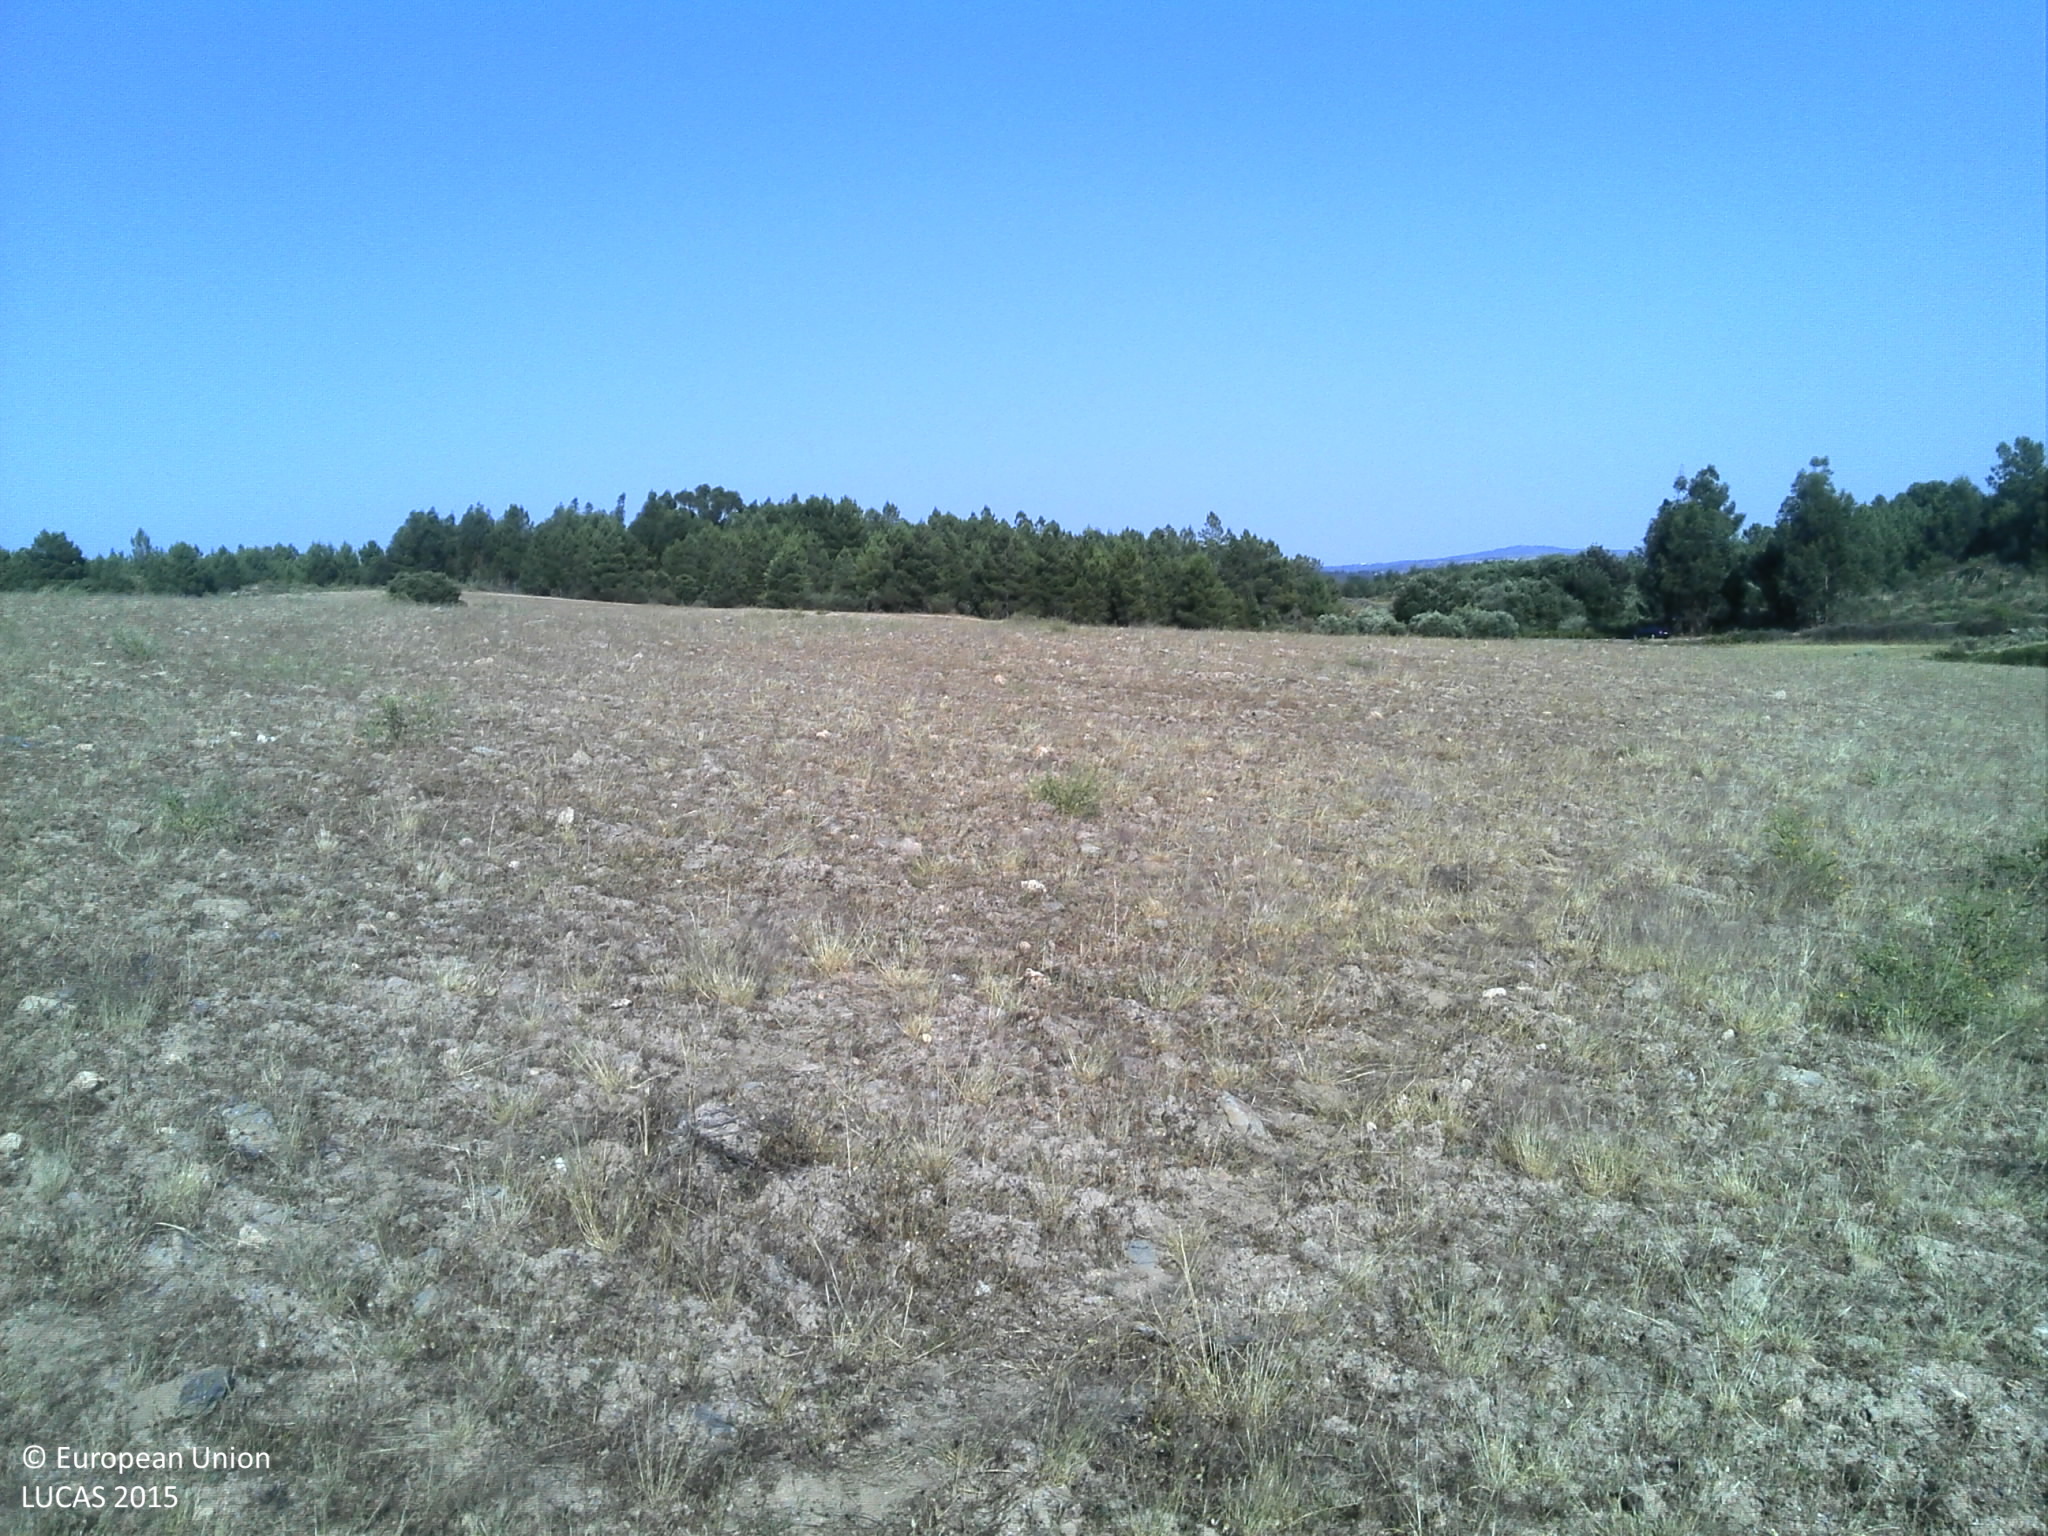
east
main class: Grassland
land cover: Spontaneously vegetated surfaces
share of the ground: 10 - 25 %
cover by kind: unconsolidated bare surface 70 %, herbaceous plants 25 %
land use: Agriculture (excluding fallow land and kitchen gardens)
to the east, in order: Spontaneously vegetated surfaces; Fences; Spontaneously vegetated surfaces
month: June
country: PT
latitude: 40.0046
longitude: -7.4257
